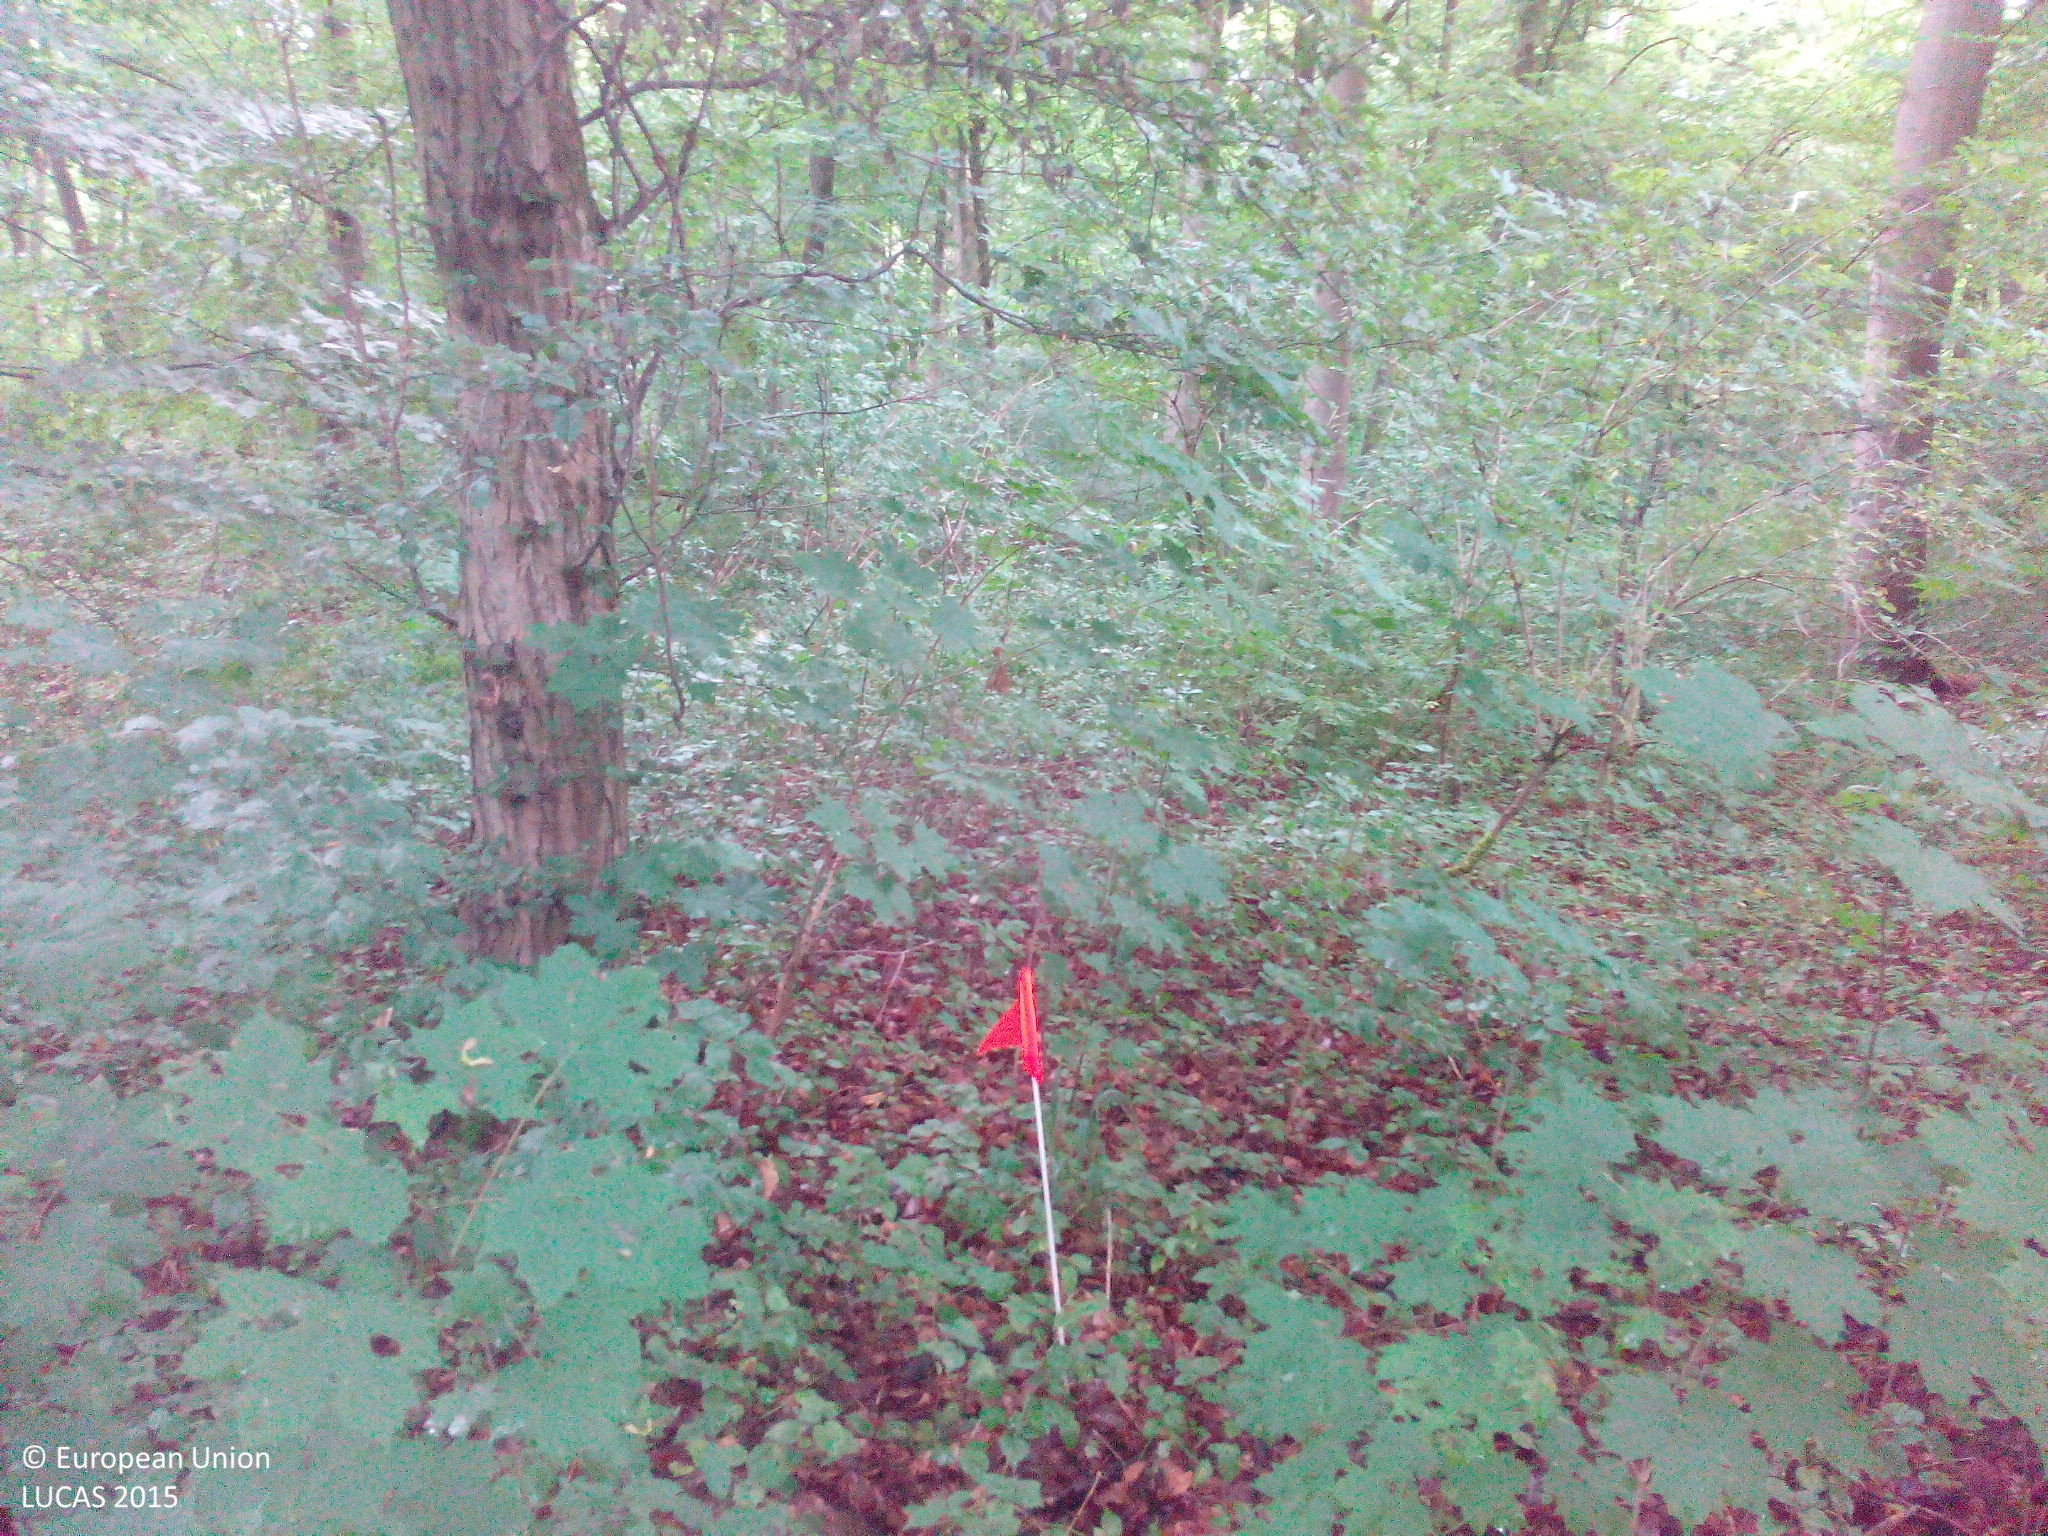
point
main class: Woodland
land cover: Broadleaved woodland
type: mesophytic deciduous forest
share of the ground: > 75 %
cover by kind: broadleaved forest trees 100 %
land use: Amenities, museums, leisure
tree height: > 5 m
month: June
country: DE
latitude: 49.8749
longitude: 10.9042
